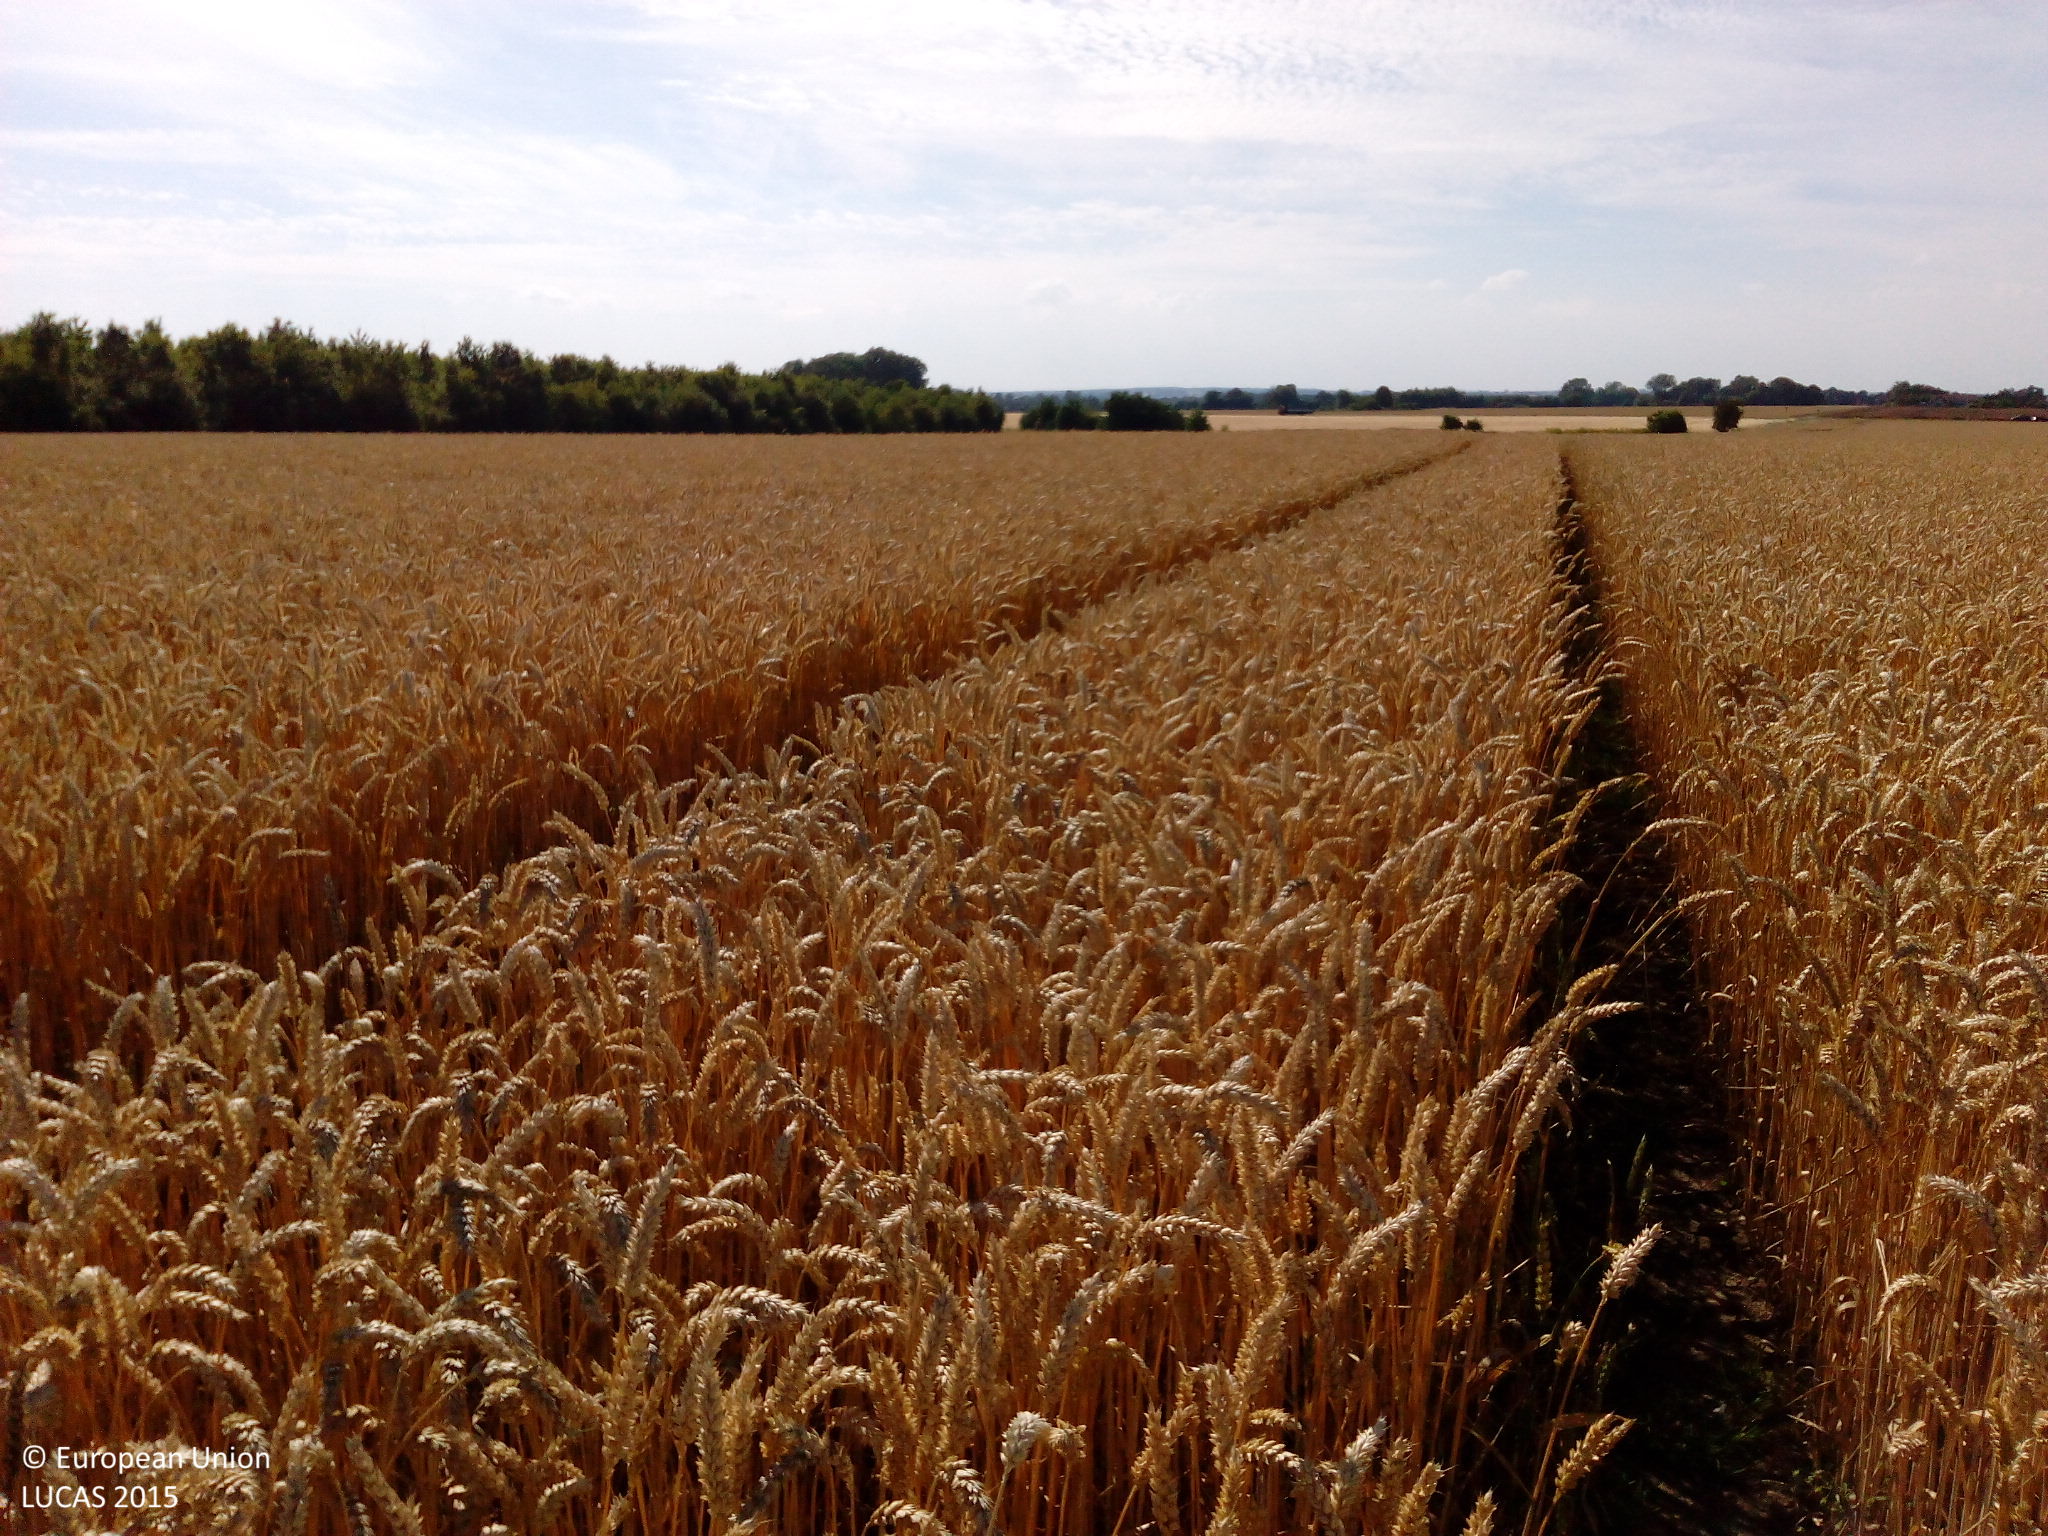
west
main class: Cropland
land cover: Common wheat
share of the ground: > 75 %
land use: Agriculture (excluding fallow land and kitchen gardens)
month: August
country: DK
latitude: 55.4023
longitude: 11.7830
